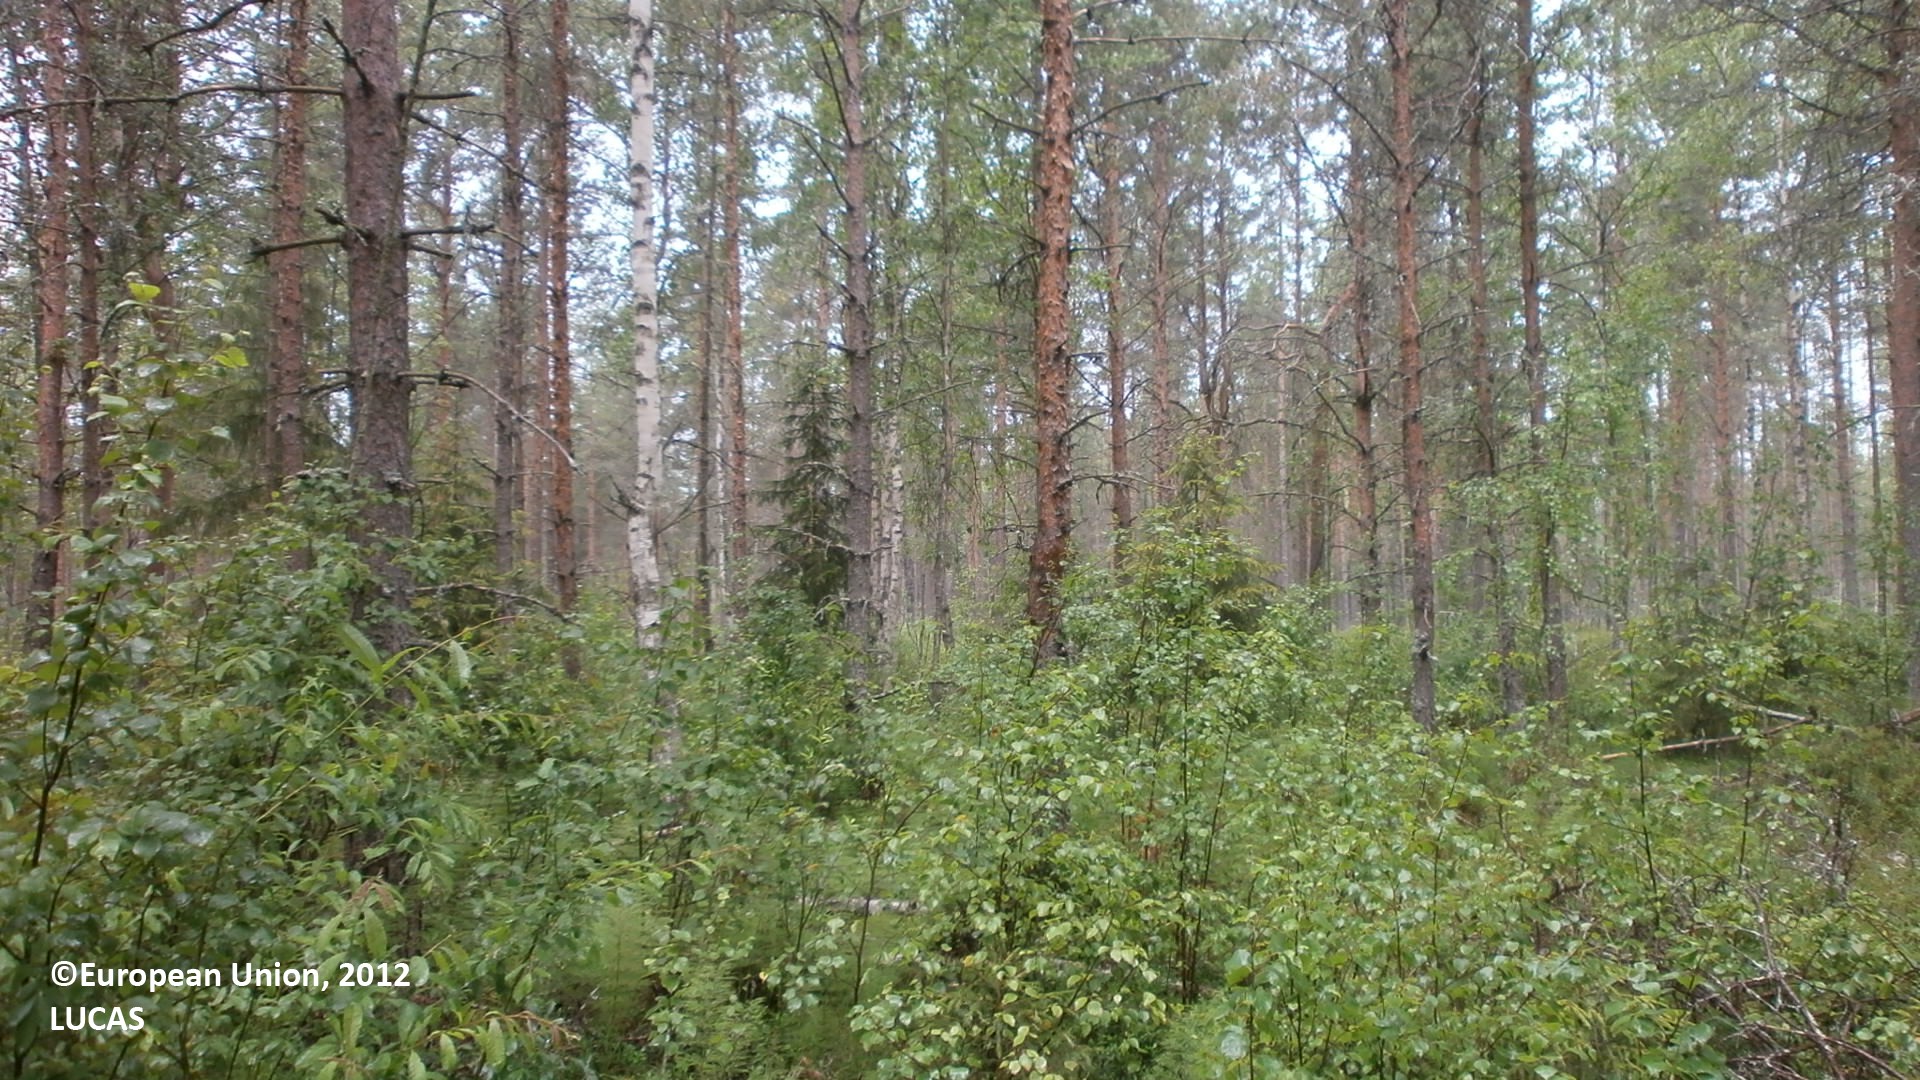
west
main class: Woodland
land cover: Pine dominated coniferous woodland
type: boreal forest
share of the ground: 50 - 75 %
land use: Forestry
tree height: > 5 m
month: July
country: FI
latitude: 64.0663
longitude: 23.8132
